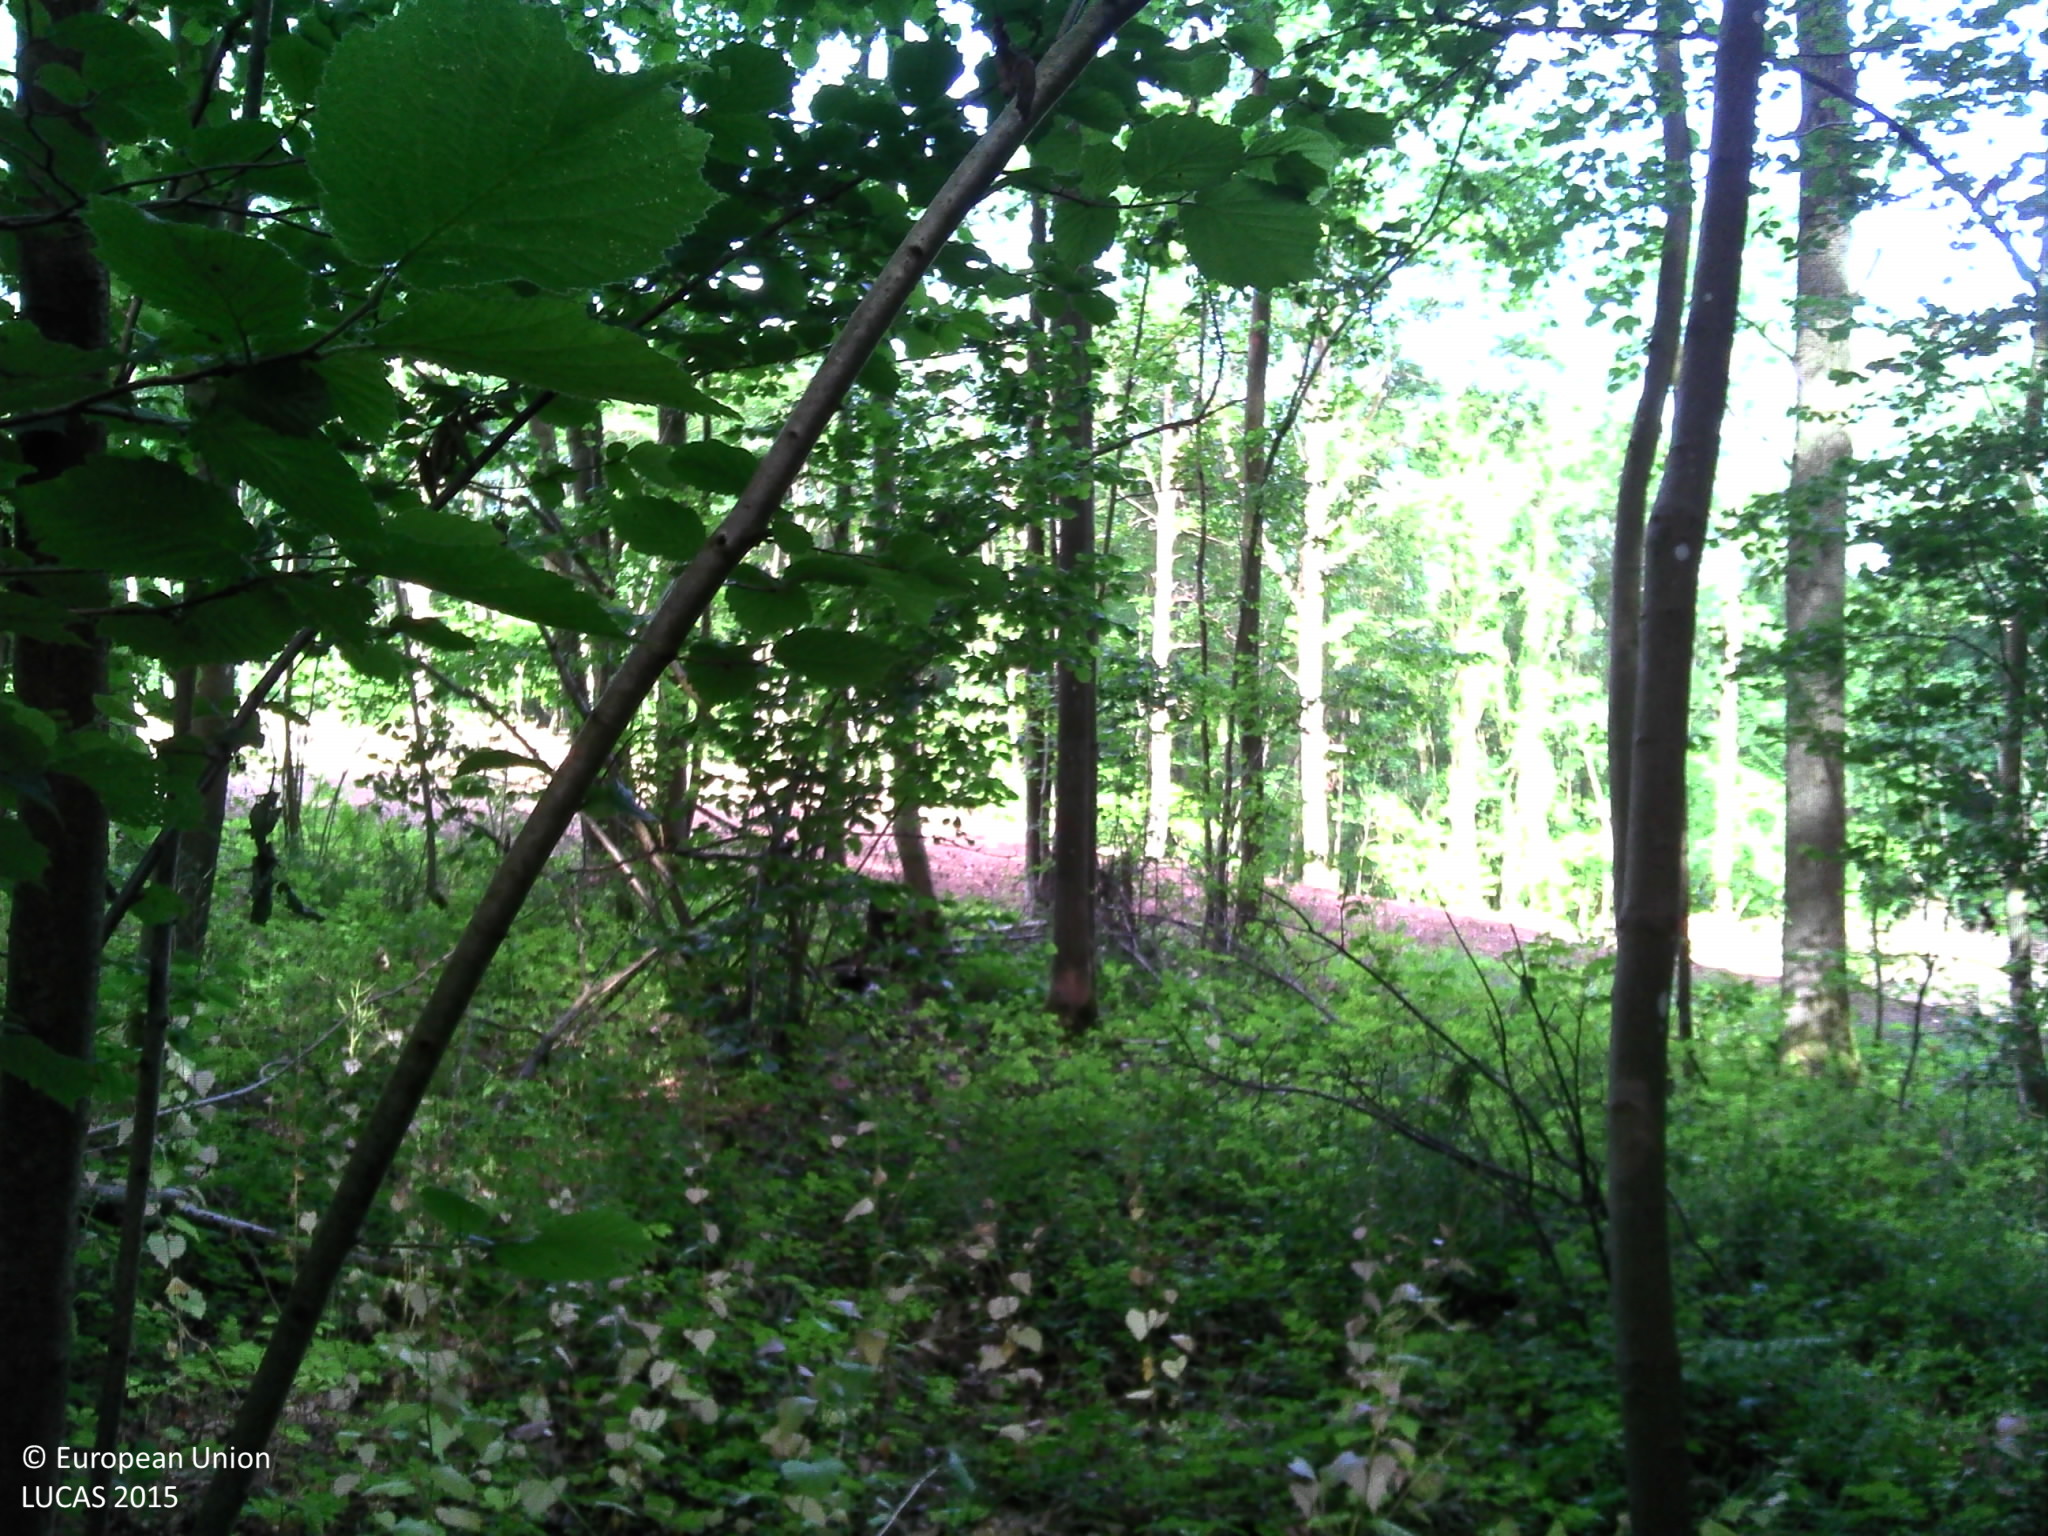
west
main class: Woodland
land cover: Broadleaved woodland
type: mesophytic deciduous forest
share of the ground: > 75 %
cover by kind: broadleaved forest trees 100 %
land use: Forestry
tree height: > 5 m
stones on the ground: < 10 %
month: June
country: BE
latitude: 50.2865
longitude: 4.9023
